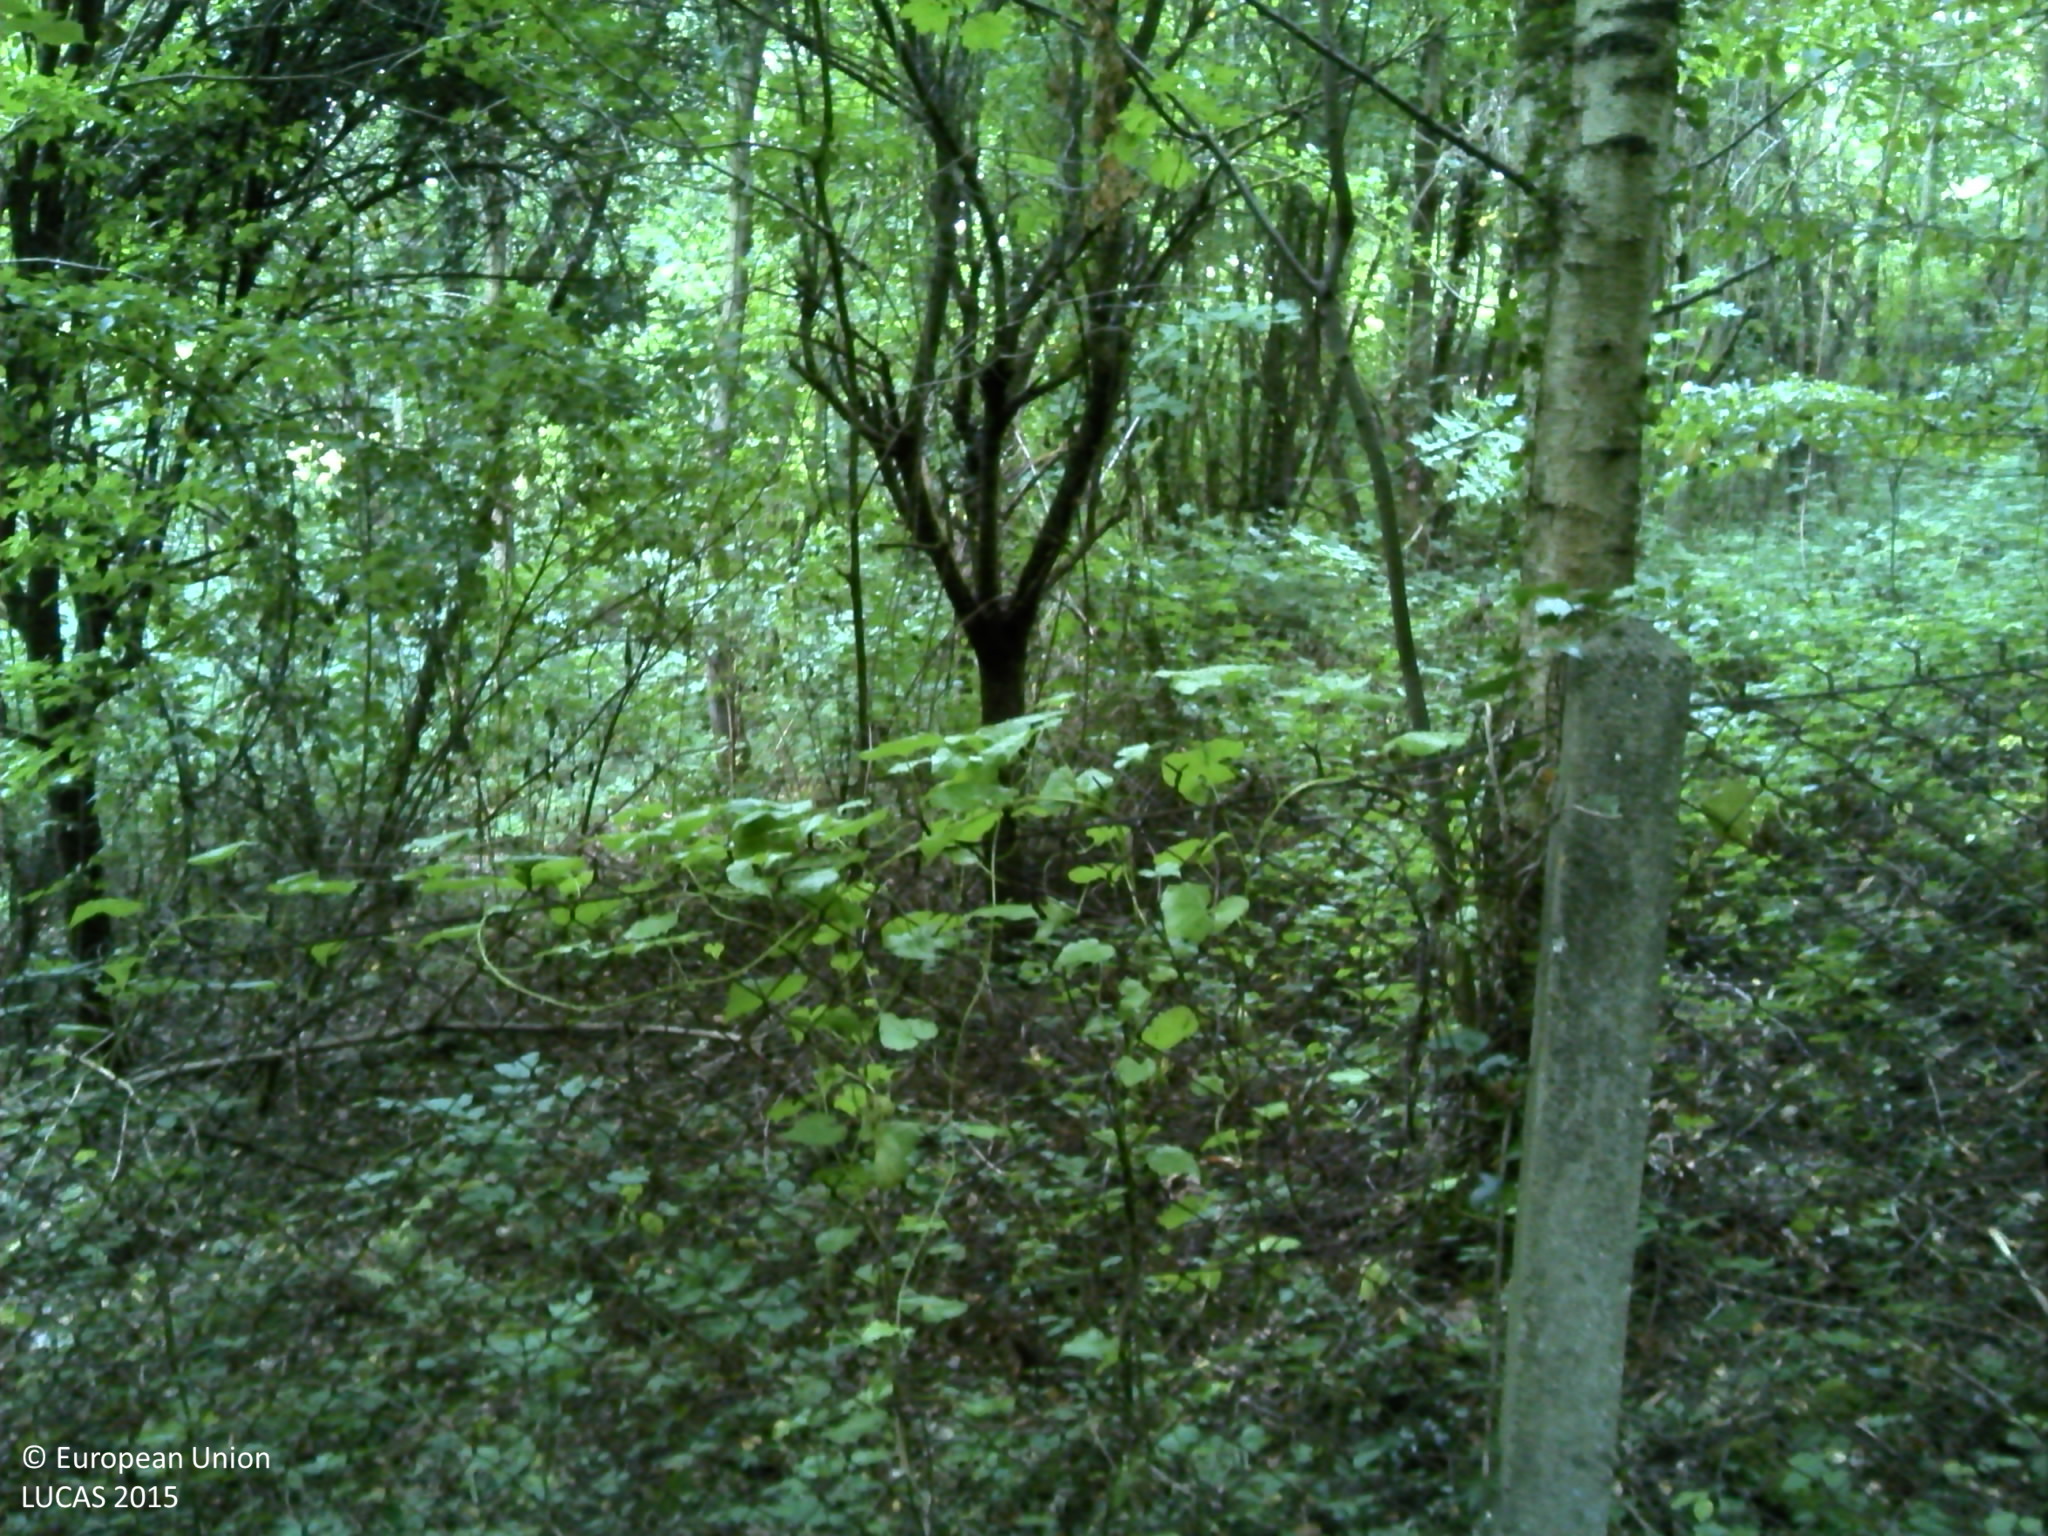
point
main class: Woodland
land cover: Broadleaved woodland
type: mesophytic deciduous forest
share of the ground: > 75 %
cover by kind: broadleaved forest trees 95 %, herbaceous plants 5 %
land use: Forestry
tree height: > 5 m
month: July
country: FR
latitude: 48.7524
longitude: 1.8377
